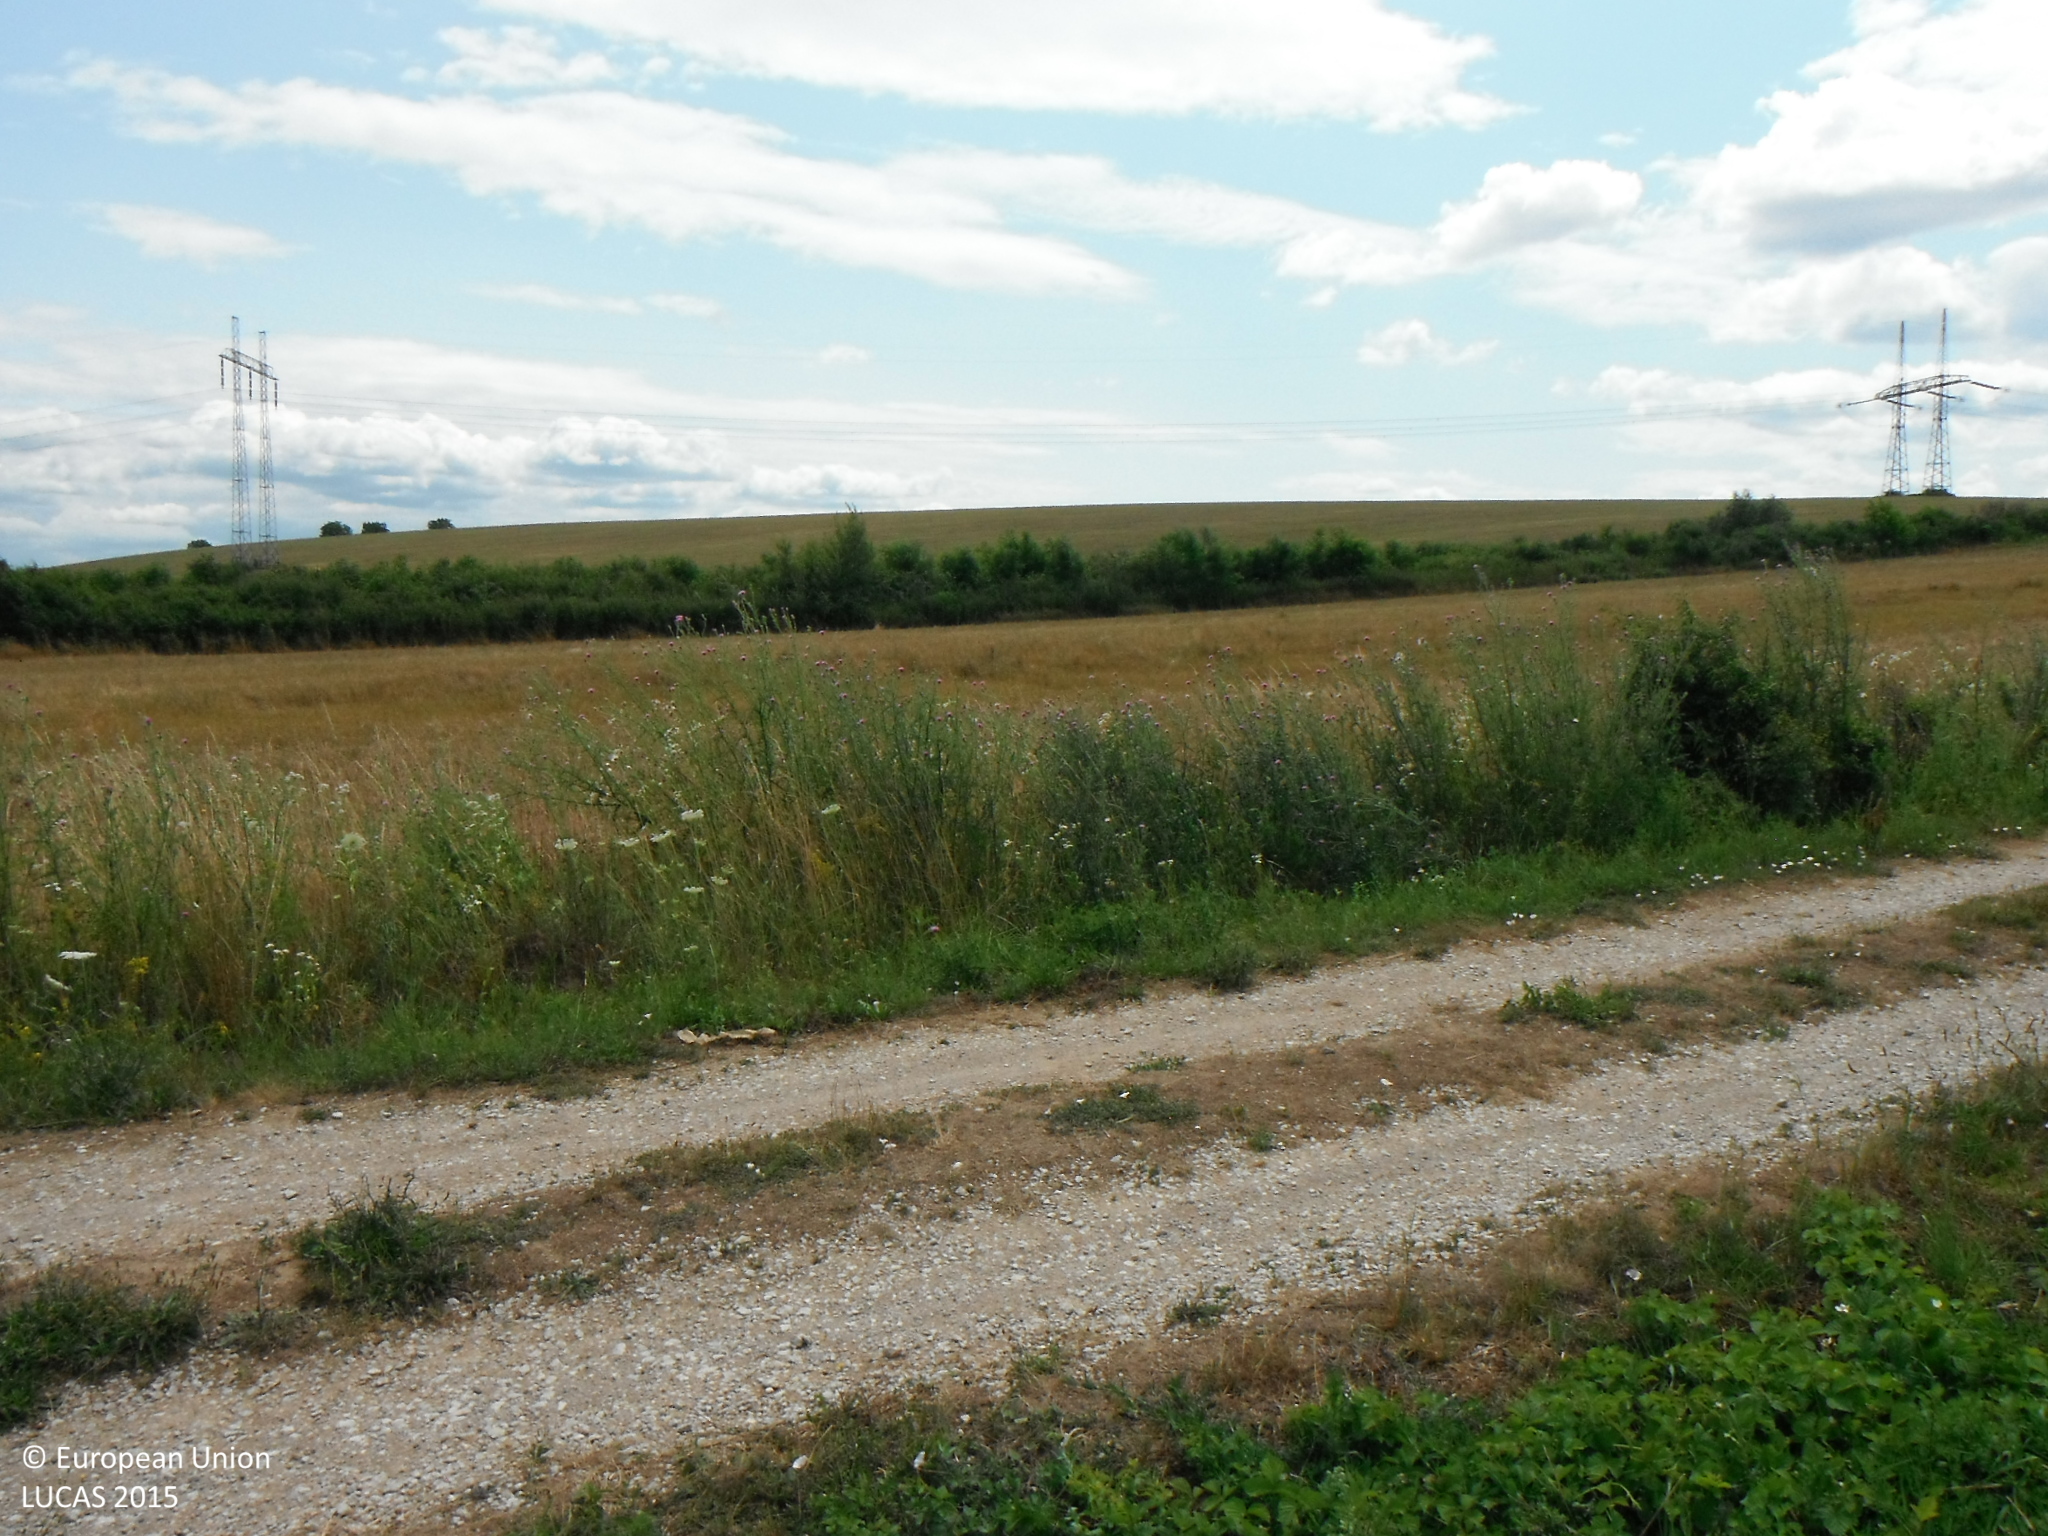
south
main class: Grassland
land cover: Spontaneously vegetated surfaces
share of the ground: > 75 %
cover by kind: herbaceous plants 100 %
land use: Semi-natural and natural areas not in use
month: July
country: SK
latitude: 48.3484
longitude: 20.1917
